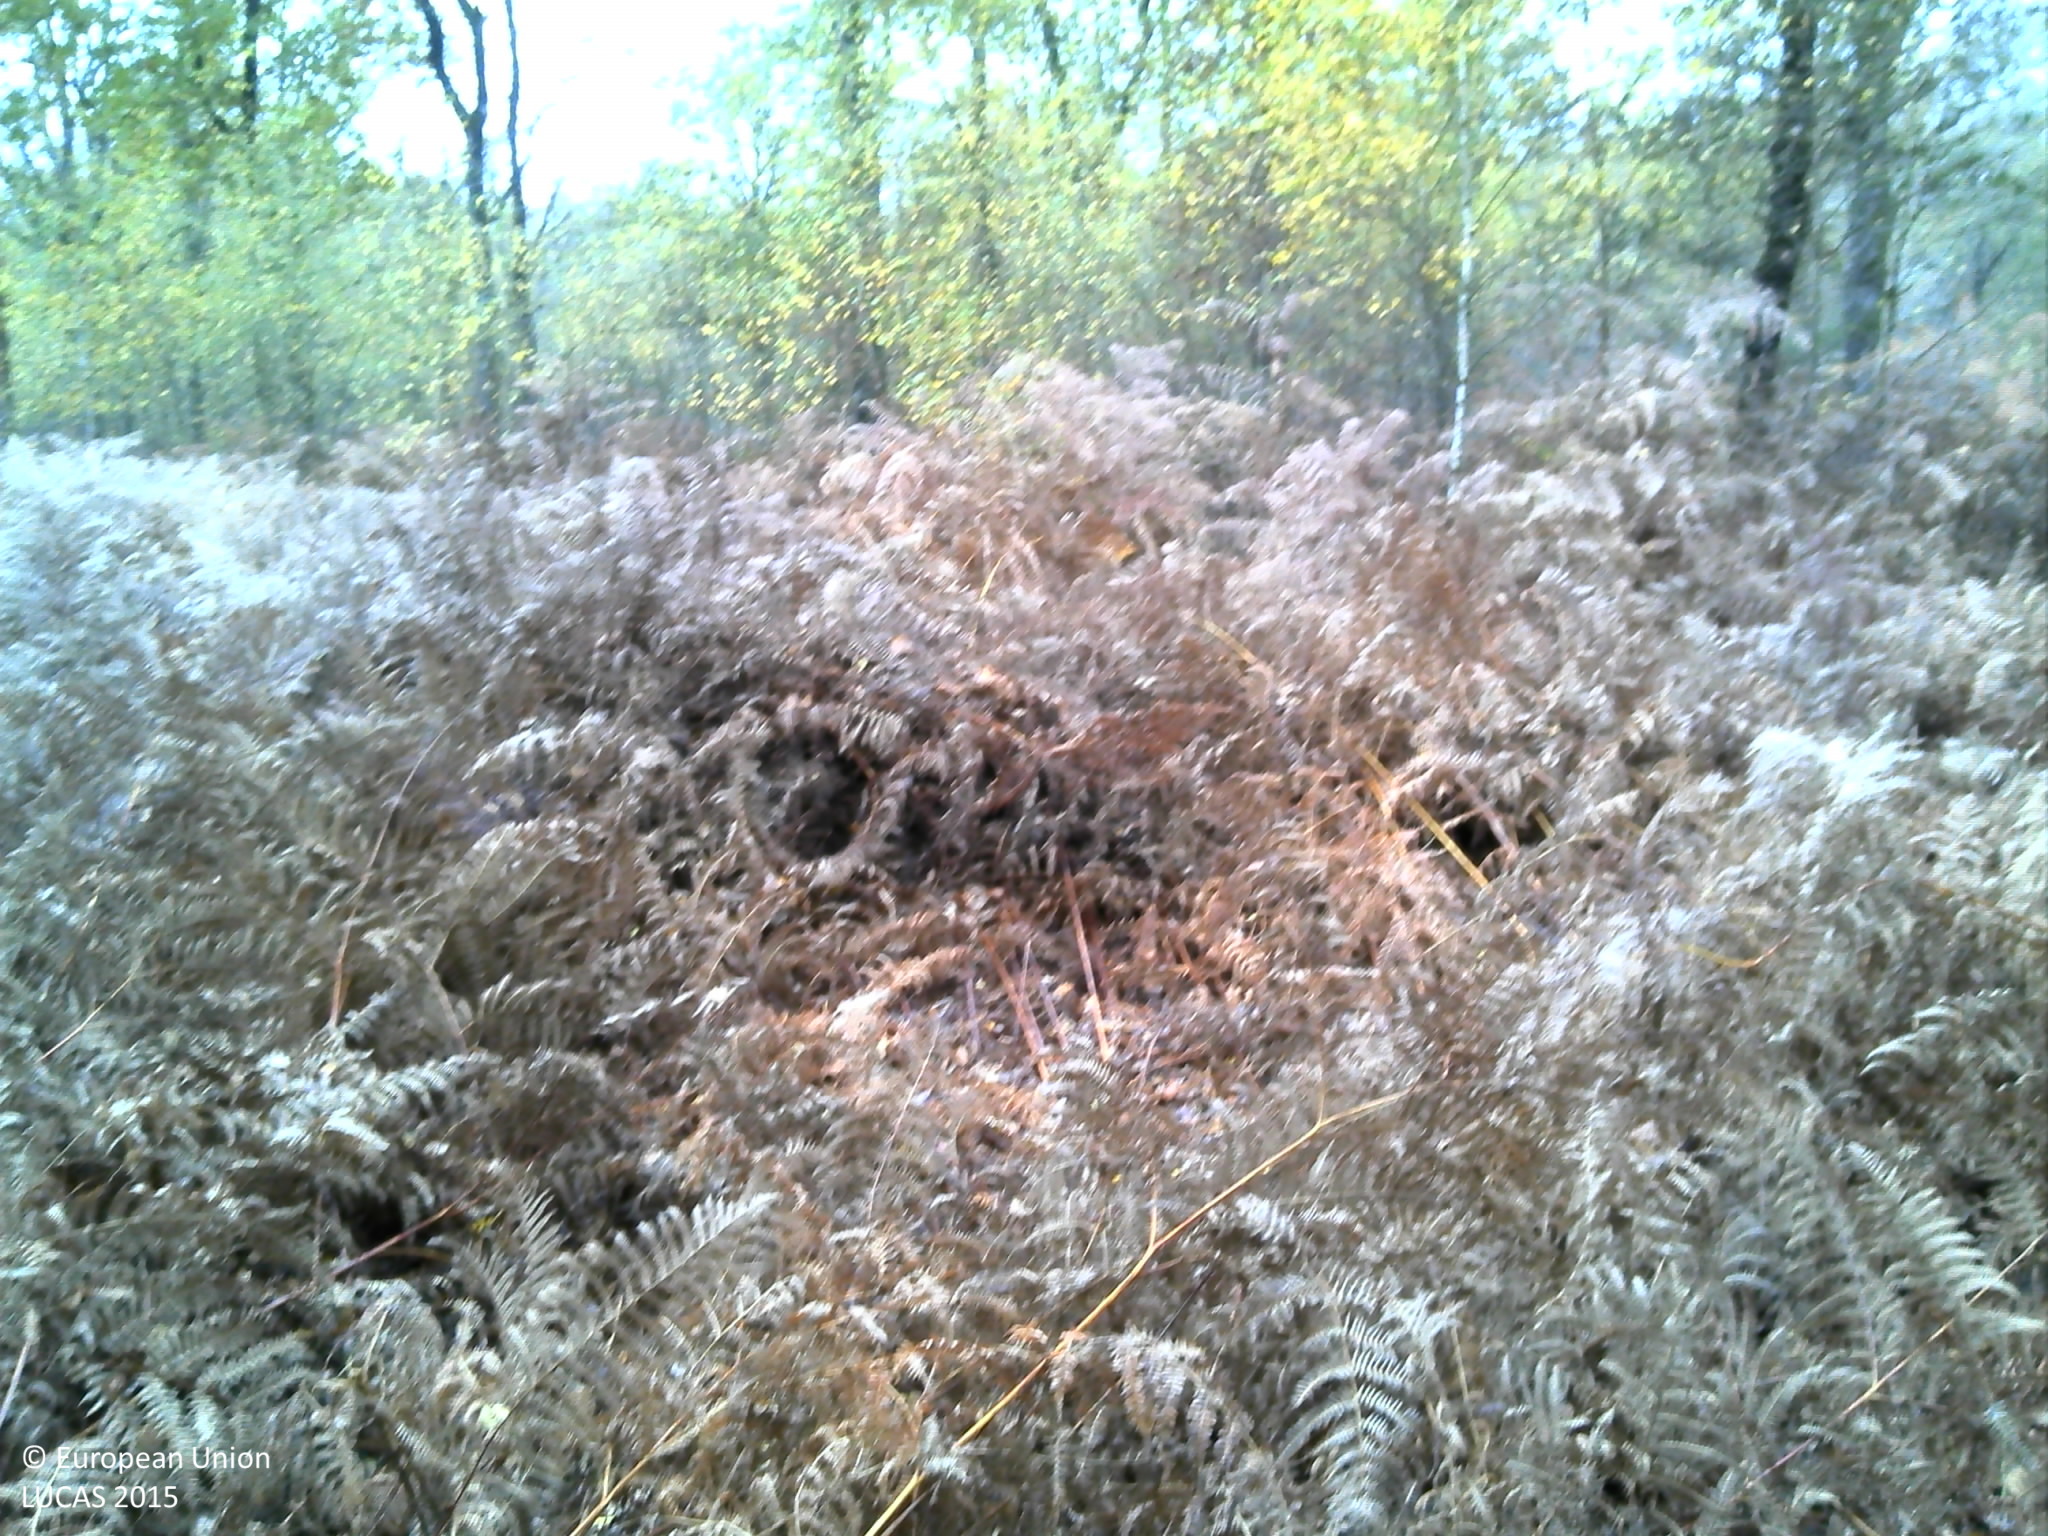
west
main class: Woodland
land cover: Broadleaved woodland
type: acidophilous oak and oak-birch forest
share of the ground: 50 - 75 %
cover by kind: broadleaved forest trees 70 %, herbaceous plants 30 %
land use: Forestry
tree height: > 5 m
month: November
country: FR
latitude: 47.6512
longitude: -1.3716
